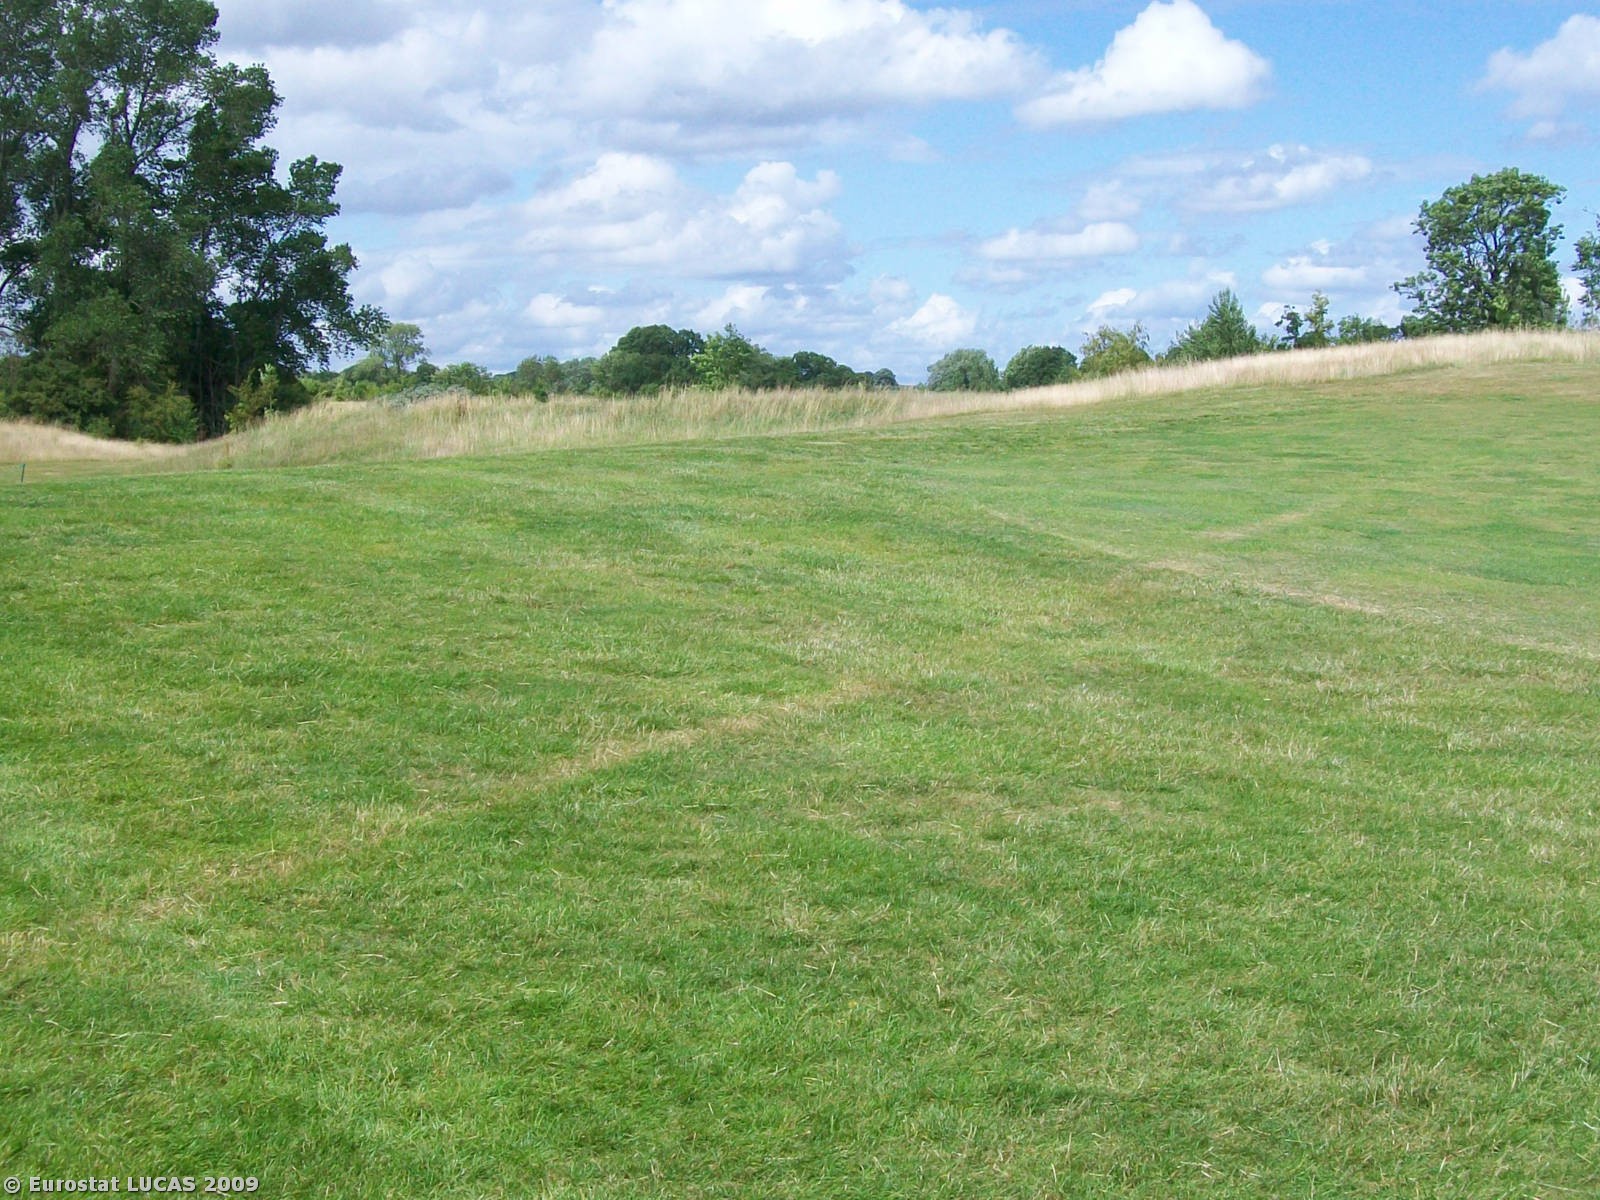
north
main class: Grassland
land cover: Grassland with sparse tree/shrub cover
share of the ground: > 75 %
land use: Sport
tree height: > 5 m
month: July
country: GB
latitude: 51.3752
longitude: -2.2594
